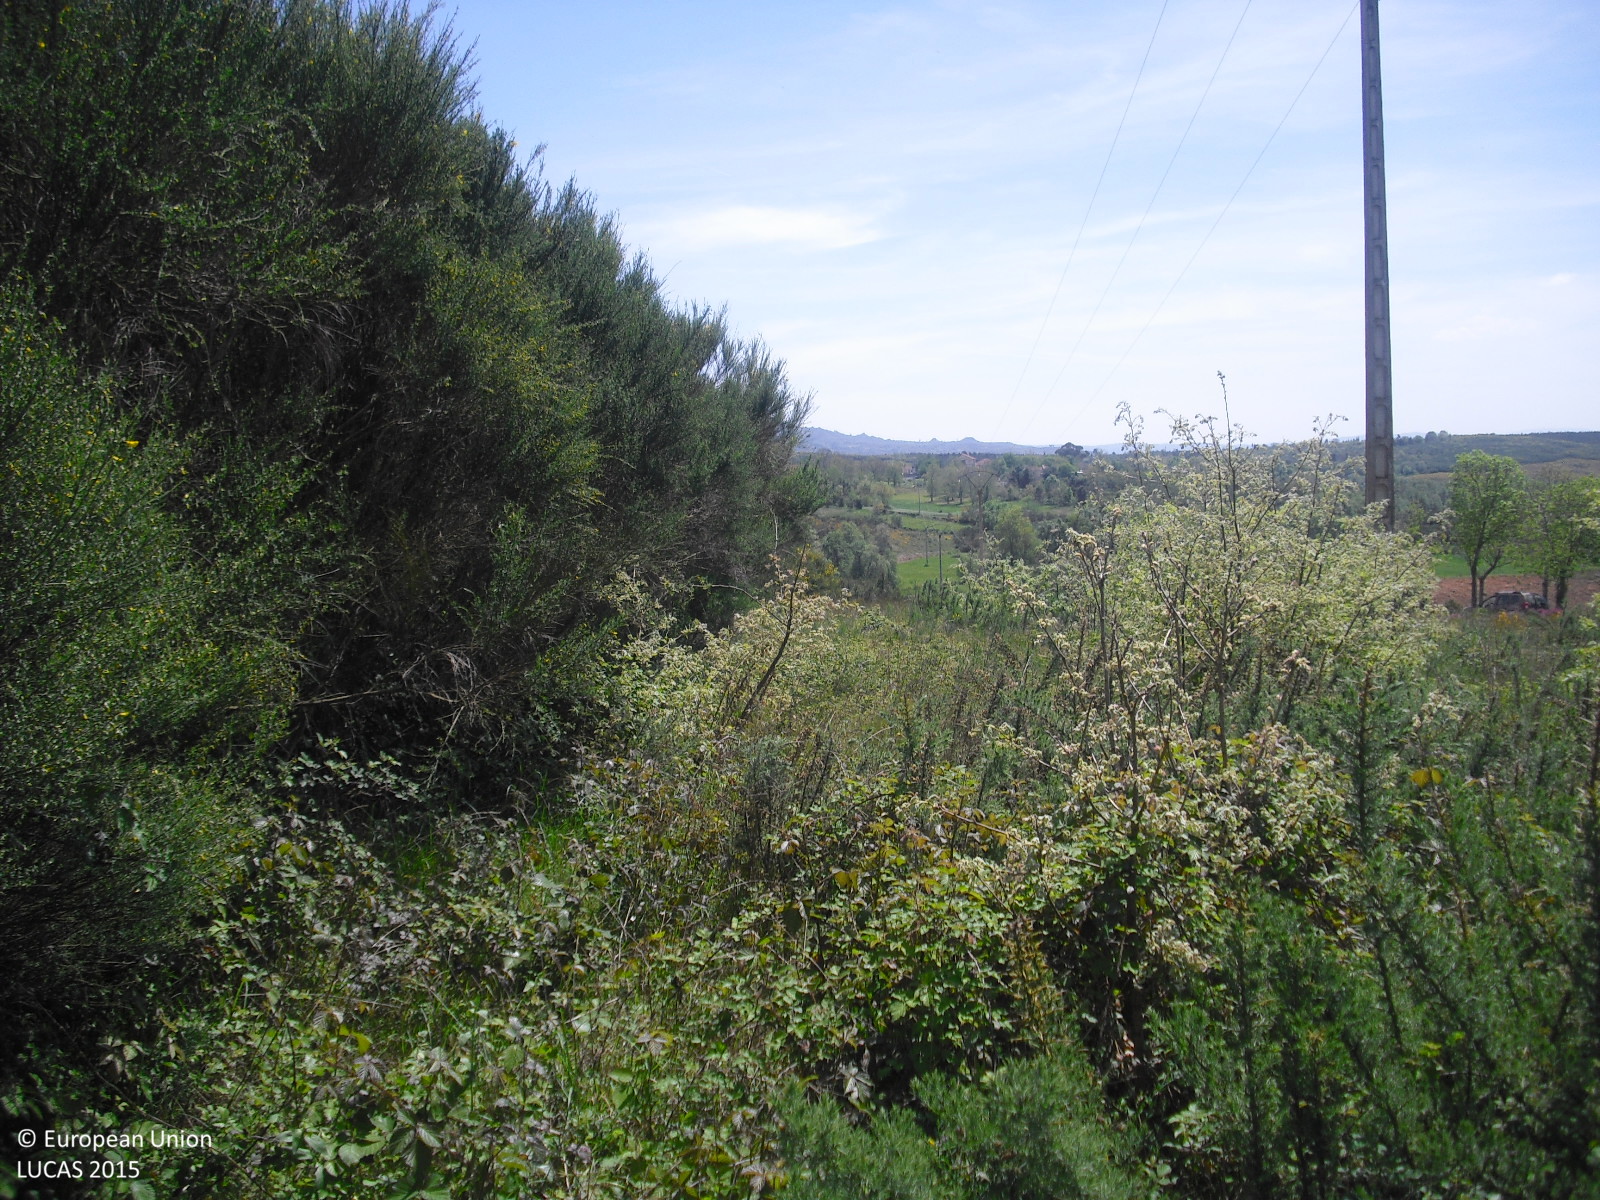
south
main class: Shrubland
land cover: Shrubland with sparse tree cover
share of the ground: > 75 %
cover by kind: shrubs 95 %, broadleaved forest trees 5 %
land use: Abandoned areas
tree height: < 5 m
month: May
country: ES
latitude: 41.9156
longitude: -7.3592
